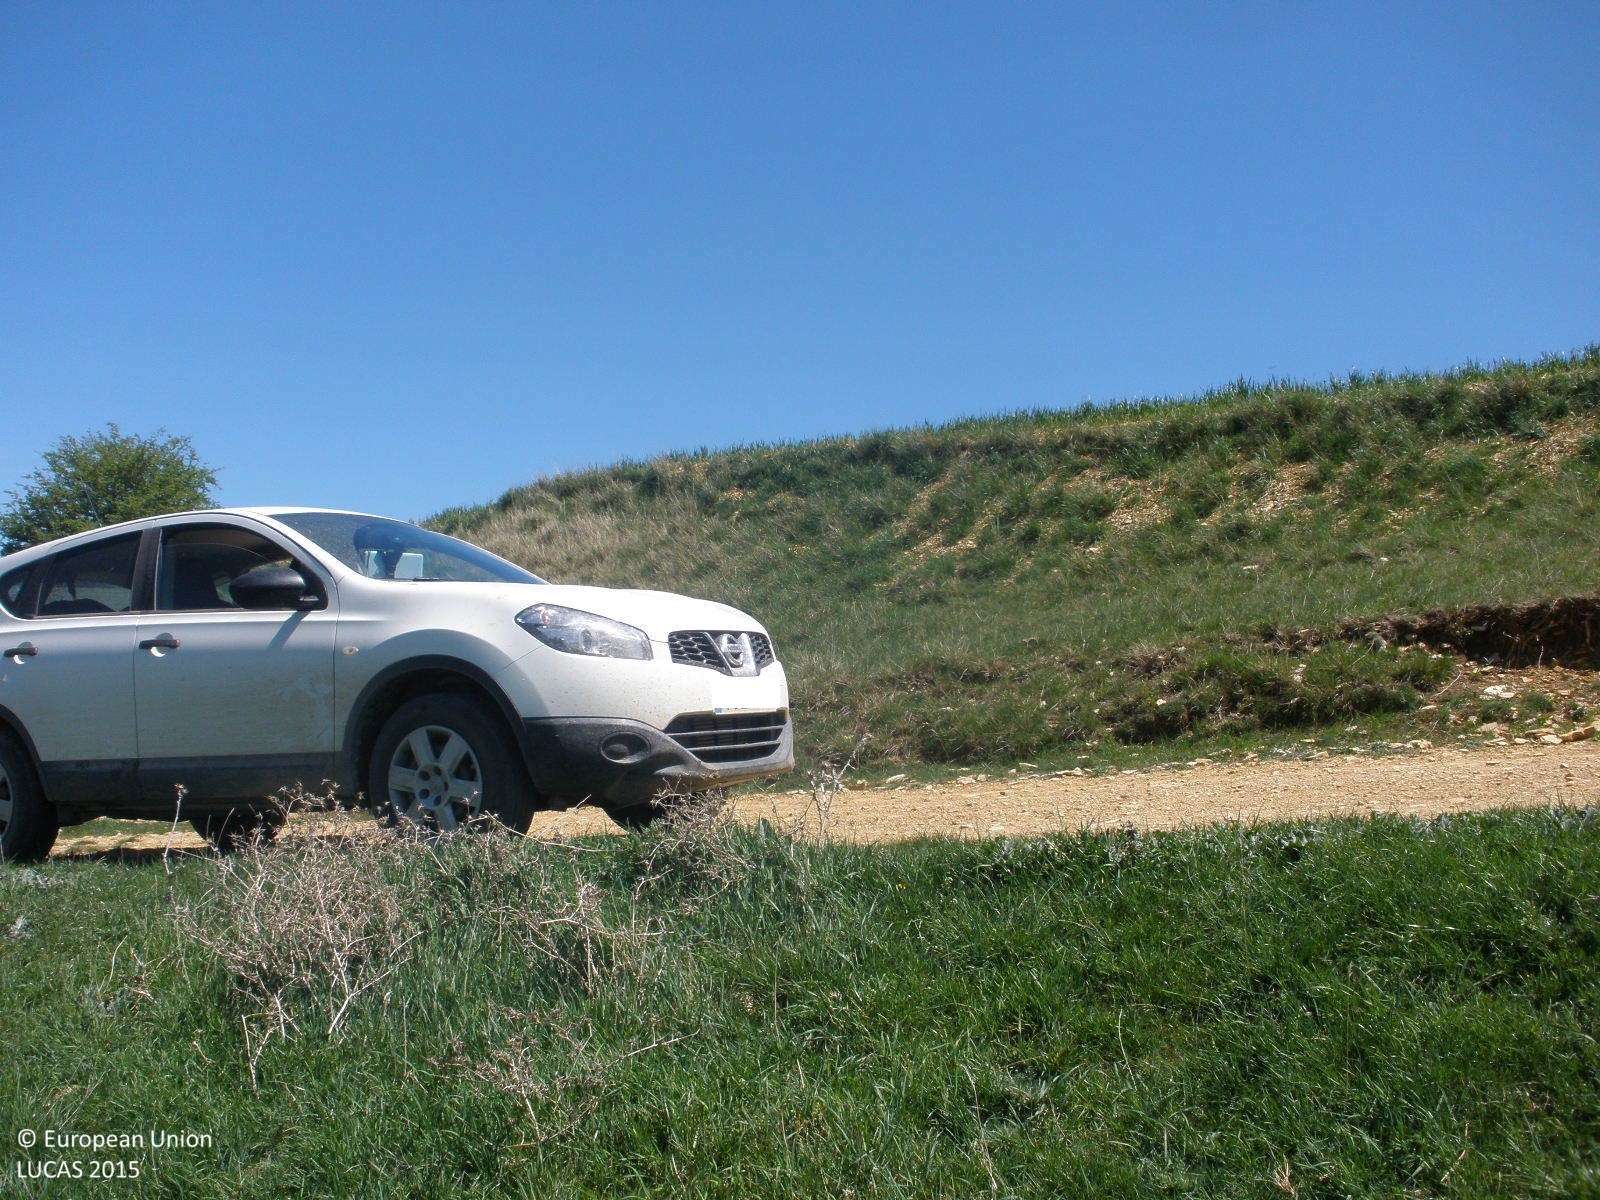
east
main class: Grassland
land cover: Grassland without tree/shrub cover
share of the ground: > 75 %
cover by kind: herbaceous plants 100 %
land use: Semi-natural and natural areas not in use
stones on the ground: < 10 %
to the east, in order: Grassland without tree/shrub cover; Tracks; Grassland without tree/shrub cover; Common wheat; Shruby margins; Common wheat; Shrubland without tree cover; Tracks; Shrubland without tree cover; Barley; Shruby margins; Barley
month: May
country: ES
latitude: 40.7730
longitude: -0.8780
